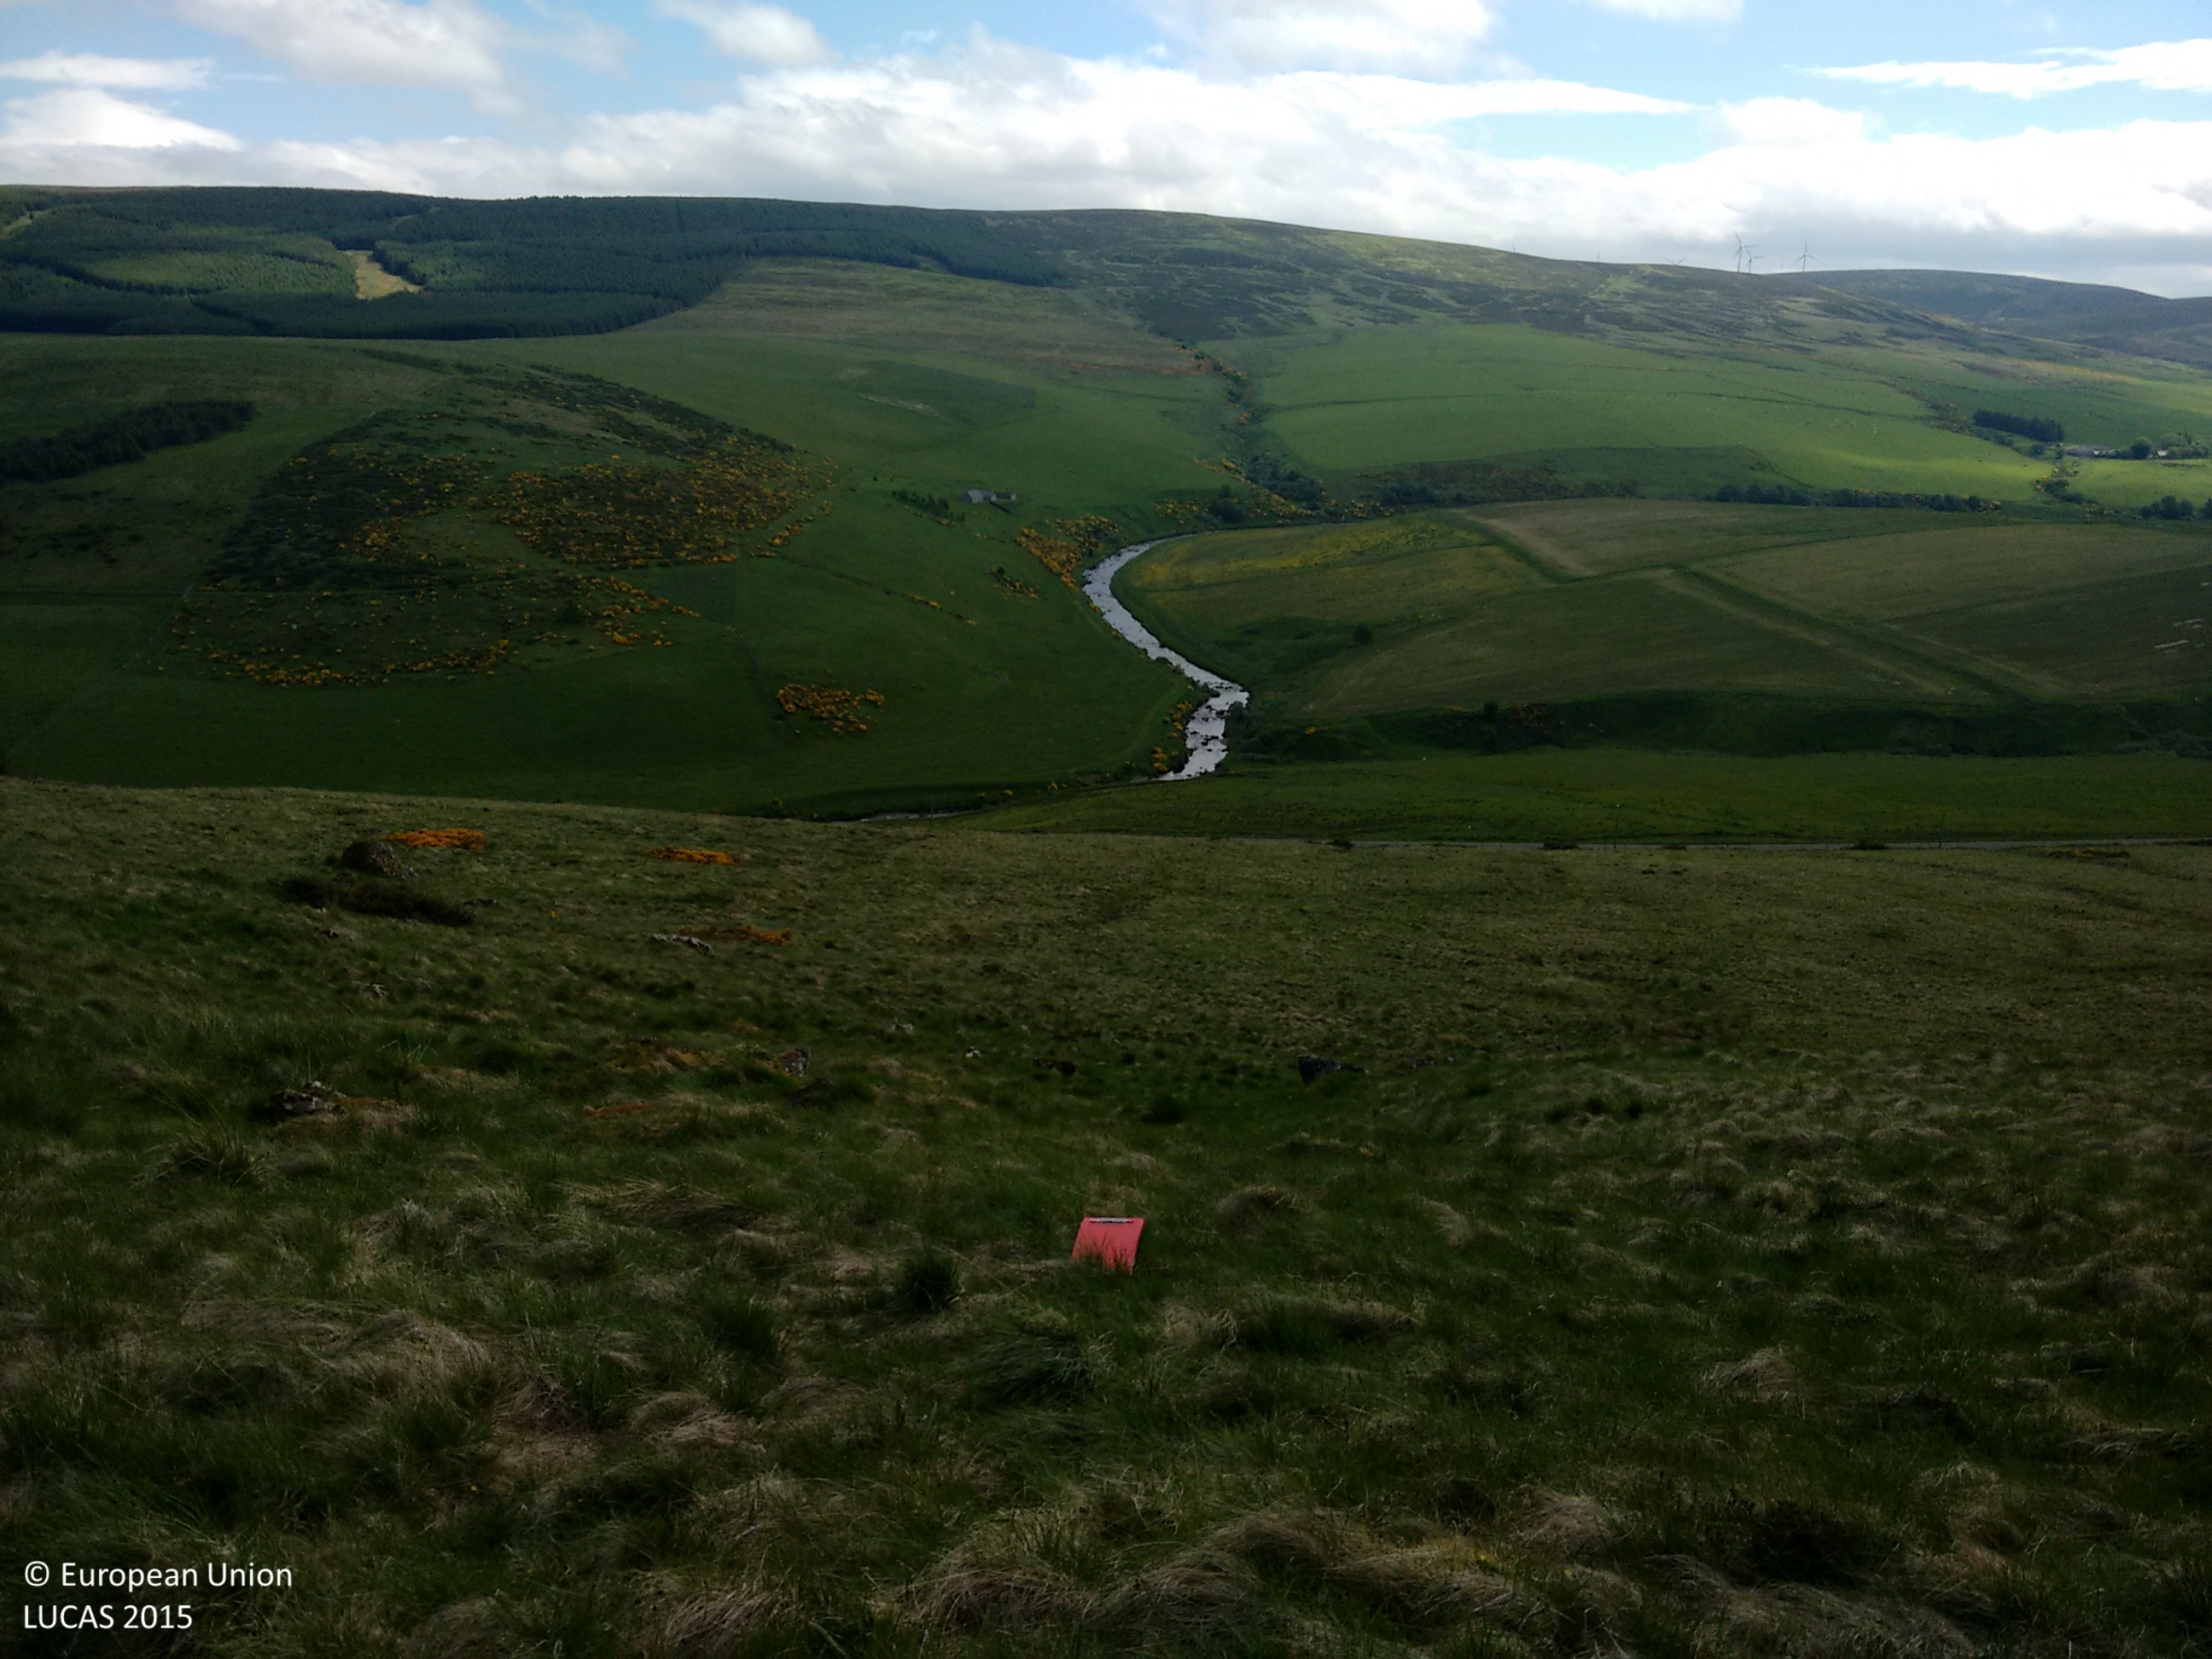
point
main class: Grassland
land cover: Grassland without tree/shrub cover
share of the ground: > 75 %
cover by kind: herbaceous plants 100 %
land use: Agriculture (excluding fallow land and kitchen gardens)
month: June
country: GB
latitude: 57.4027
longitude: -2.9931
